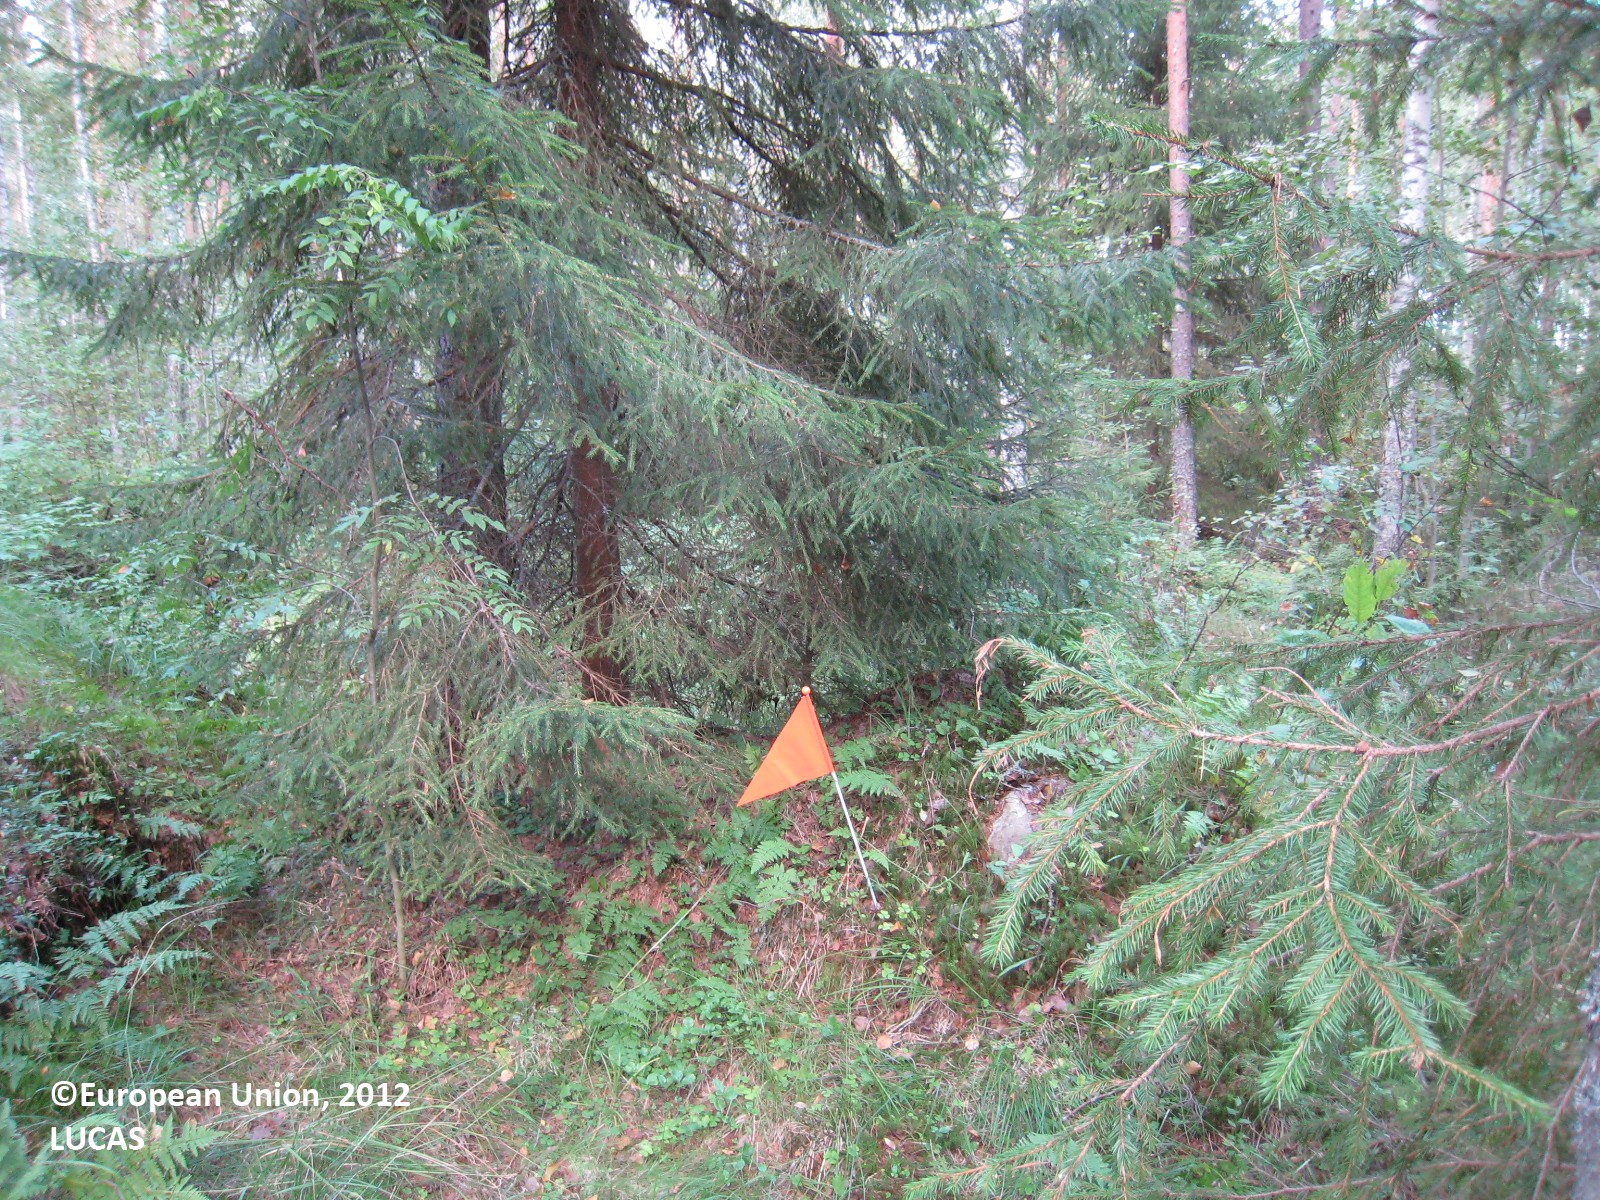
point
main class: Woodland
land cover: Other mixed woodland
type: boreal forest
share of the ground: > 75 %
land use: Forestry
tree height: > 5 m
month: August
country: FI
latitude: 62.0285
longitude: 27.2700
